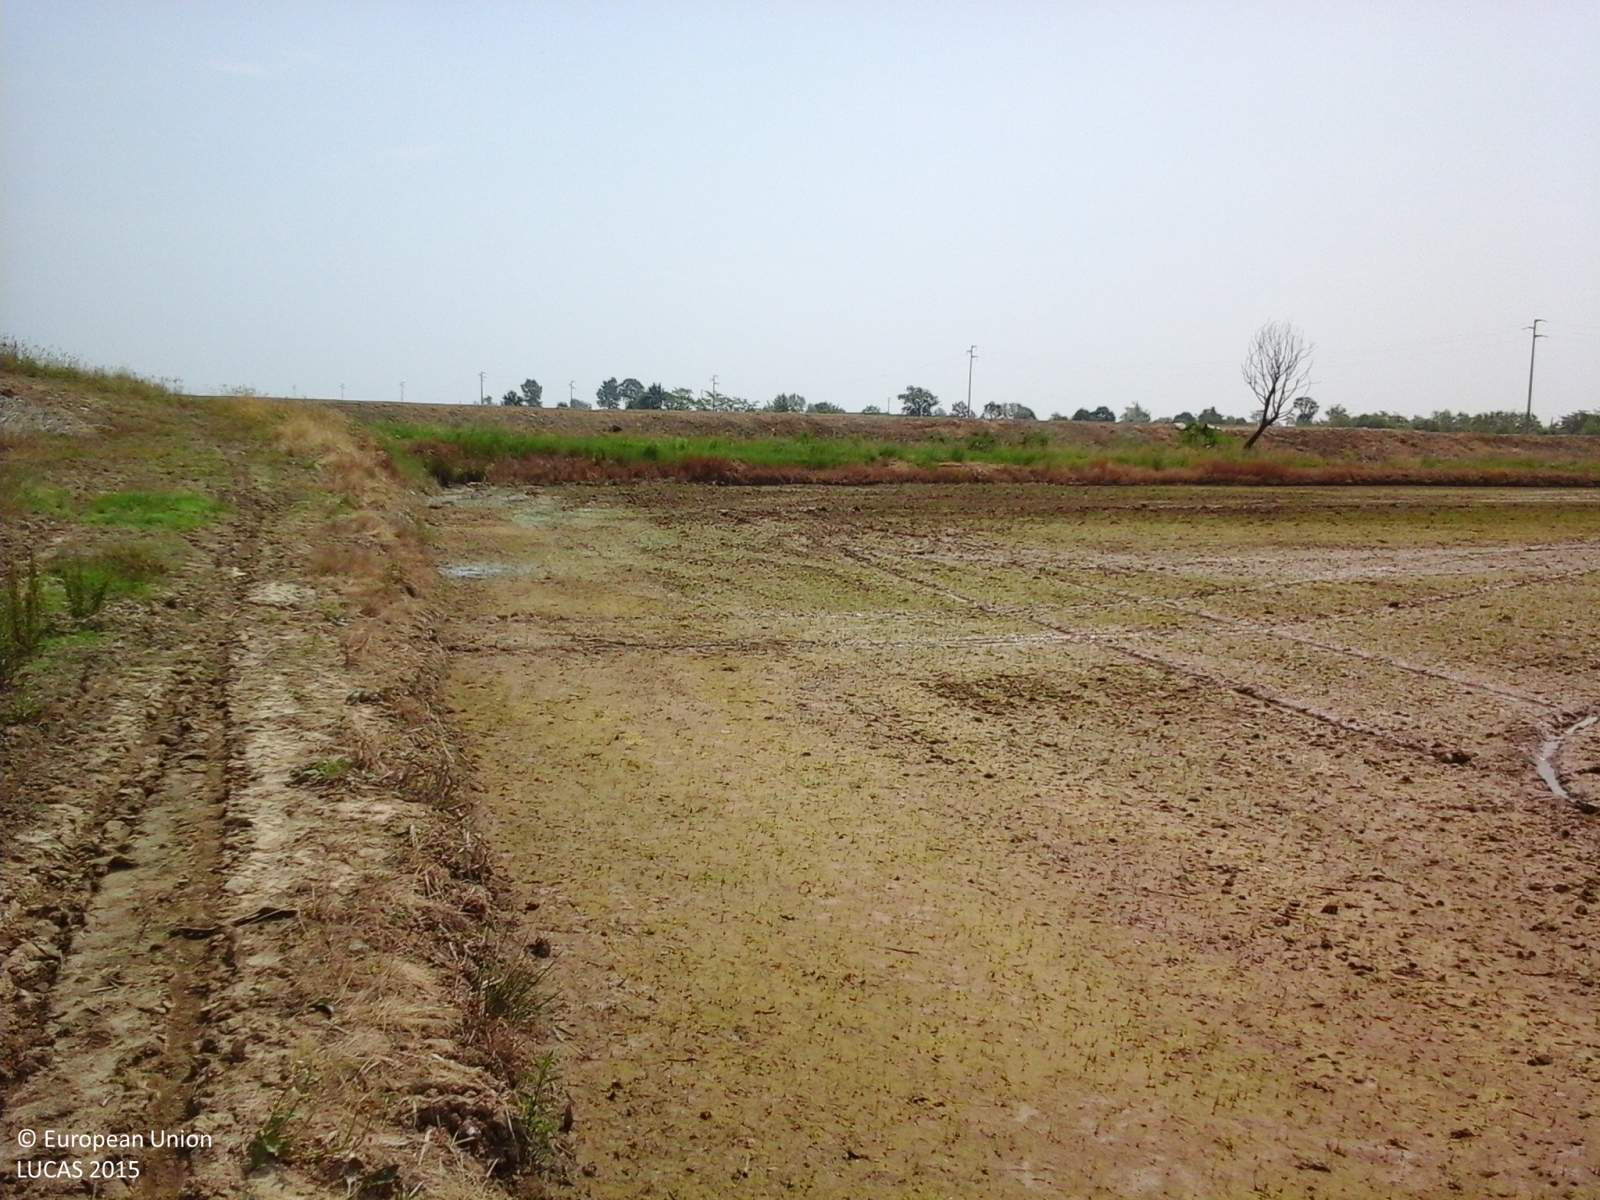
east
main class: Cropland
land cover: Rice
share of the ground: < 10 %
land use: Agriculture (excluding fallow land and kitchen gardens)
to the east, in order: Rice; Grass margins; Ditches and canals; Grass margins; Tracks; Grass margins; Ditches and canals; Grass margins; Rice; Other structural elements; Rice; Grass margins; Other structural elements; Grass margins; Rice
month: May
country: IT
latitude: 45.5083
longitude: 8.2749
